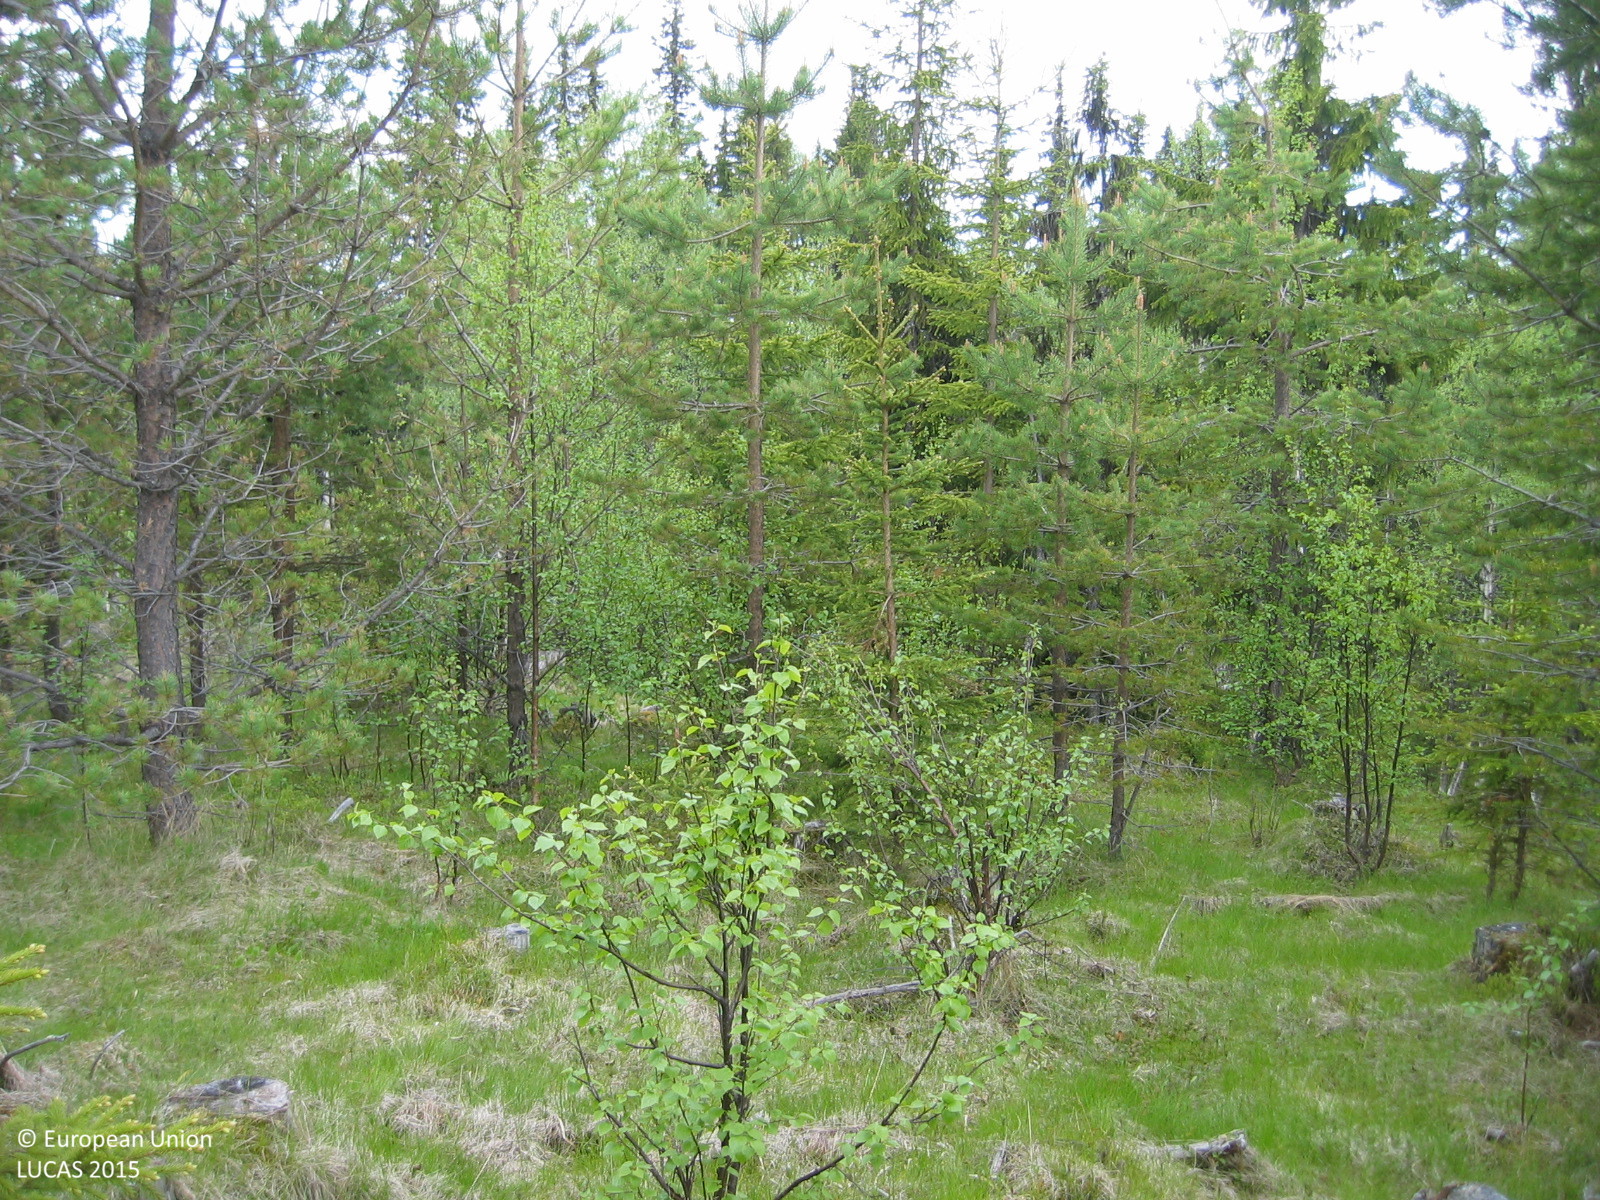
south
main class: Woodland
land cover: Other mixed woodland
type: boreal forest
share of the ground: 50 - 75 %
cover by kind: coniferous forest trees 50 %, broadleaved forest trees 25 %, herbaceous plants 25 %
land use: Forestry
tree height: < 5 m
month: June
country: SE
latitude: 63.5351
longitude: 14.6233
